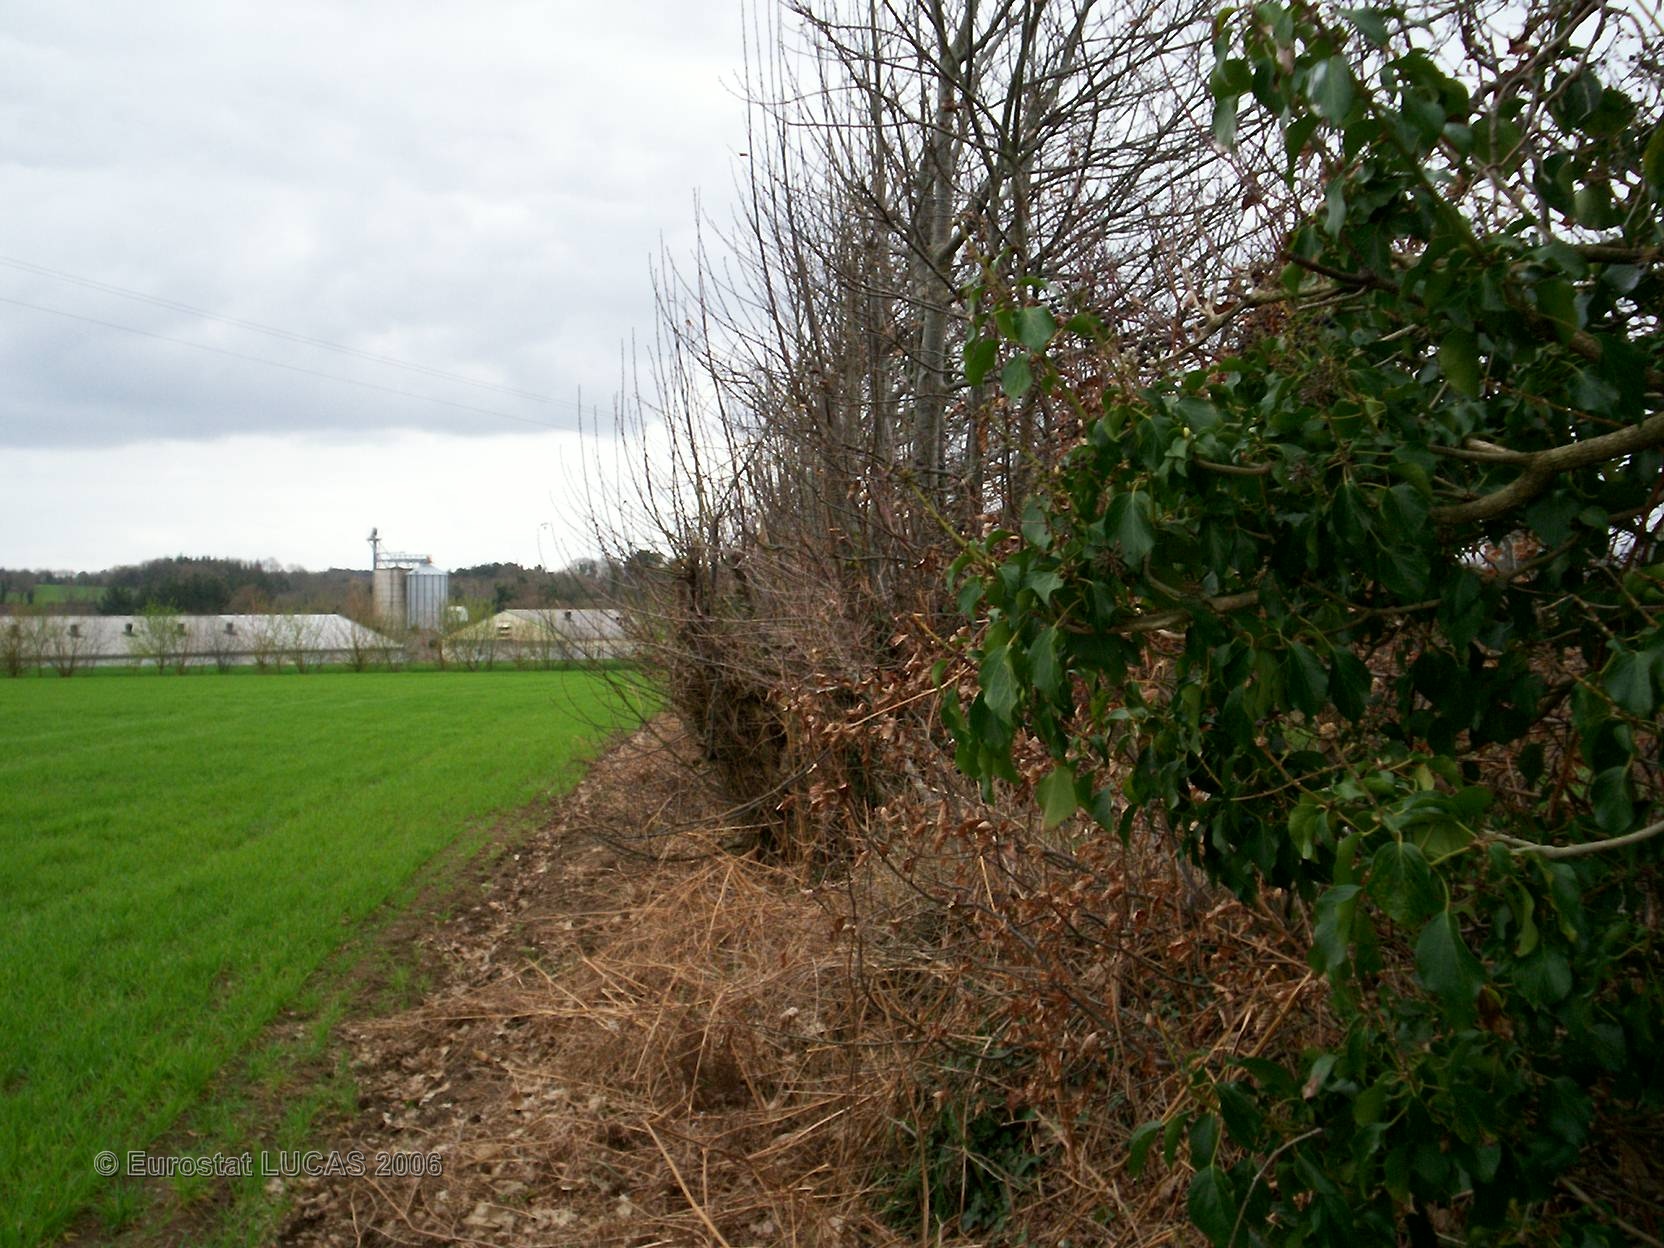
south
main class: Cropland
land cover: Common wheat
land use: Agriculture (excluding fallow land and kitchen gardens)
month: April
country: FR
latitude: 47.9818
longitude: -3.5695
